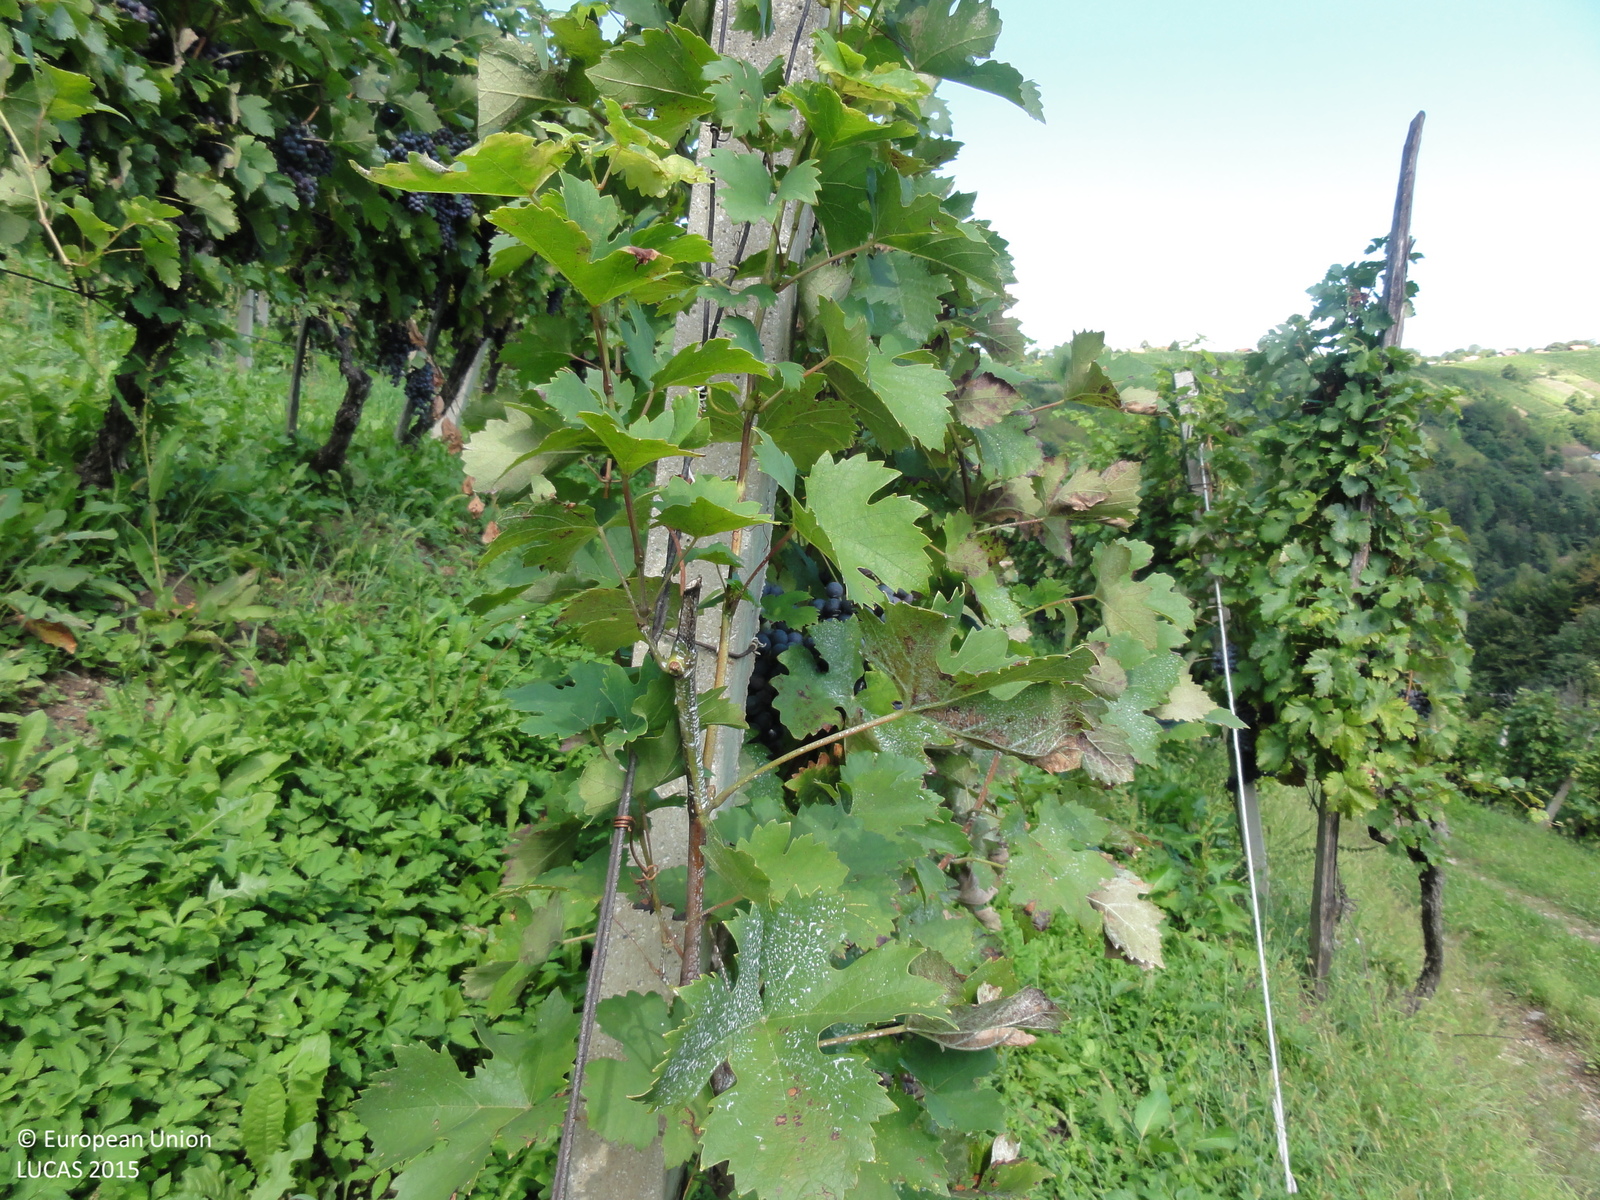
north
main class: Cropland
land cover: Vineyards
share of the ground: 50 - 75 %
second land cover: Grassland without tree/shrub cover
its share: > 75 %
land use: Agriculture (excluding fallow land and kitchen gardens)
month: September
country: SI
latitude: 45.8502
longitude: 15.4701
